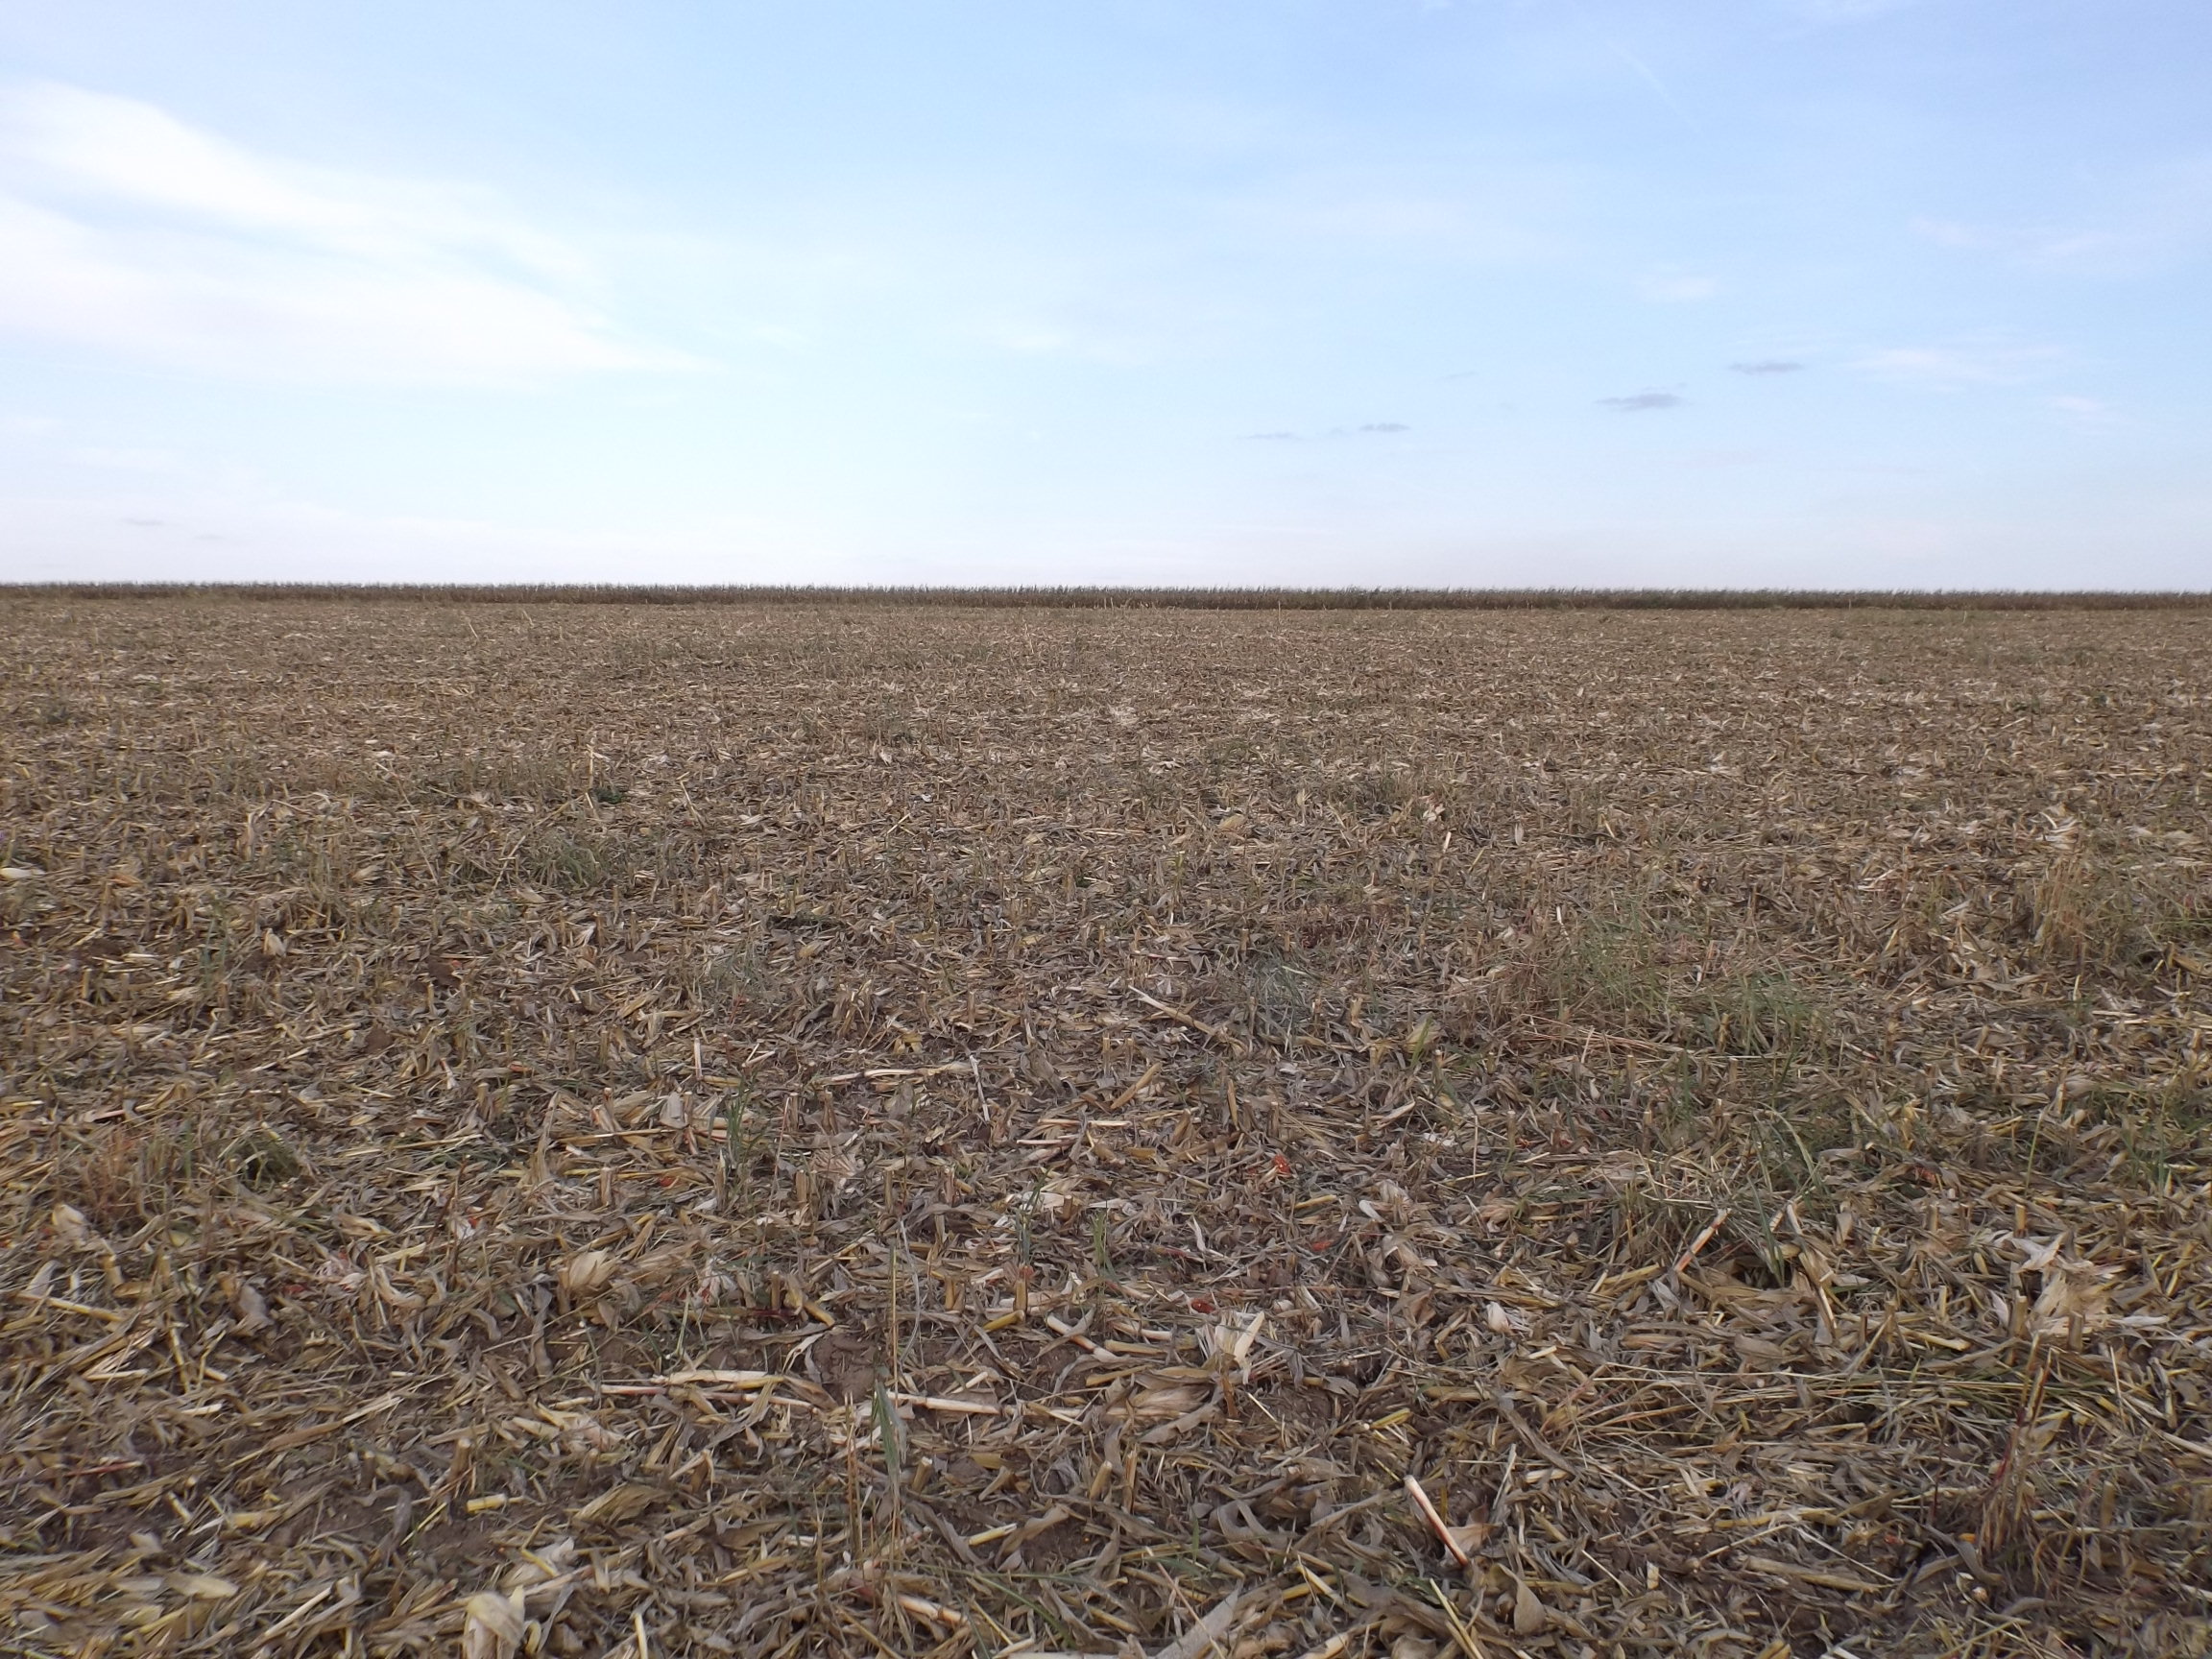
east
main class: Cropland
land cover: Maize
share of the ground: 50 - 75 %
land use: Agriculture (excluding fallow land and kitchen gardens)
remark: Harvested field
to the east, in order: Maize; Grass margins; Maize
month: October
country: BG
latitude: 43.9572
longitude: 26.8297
